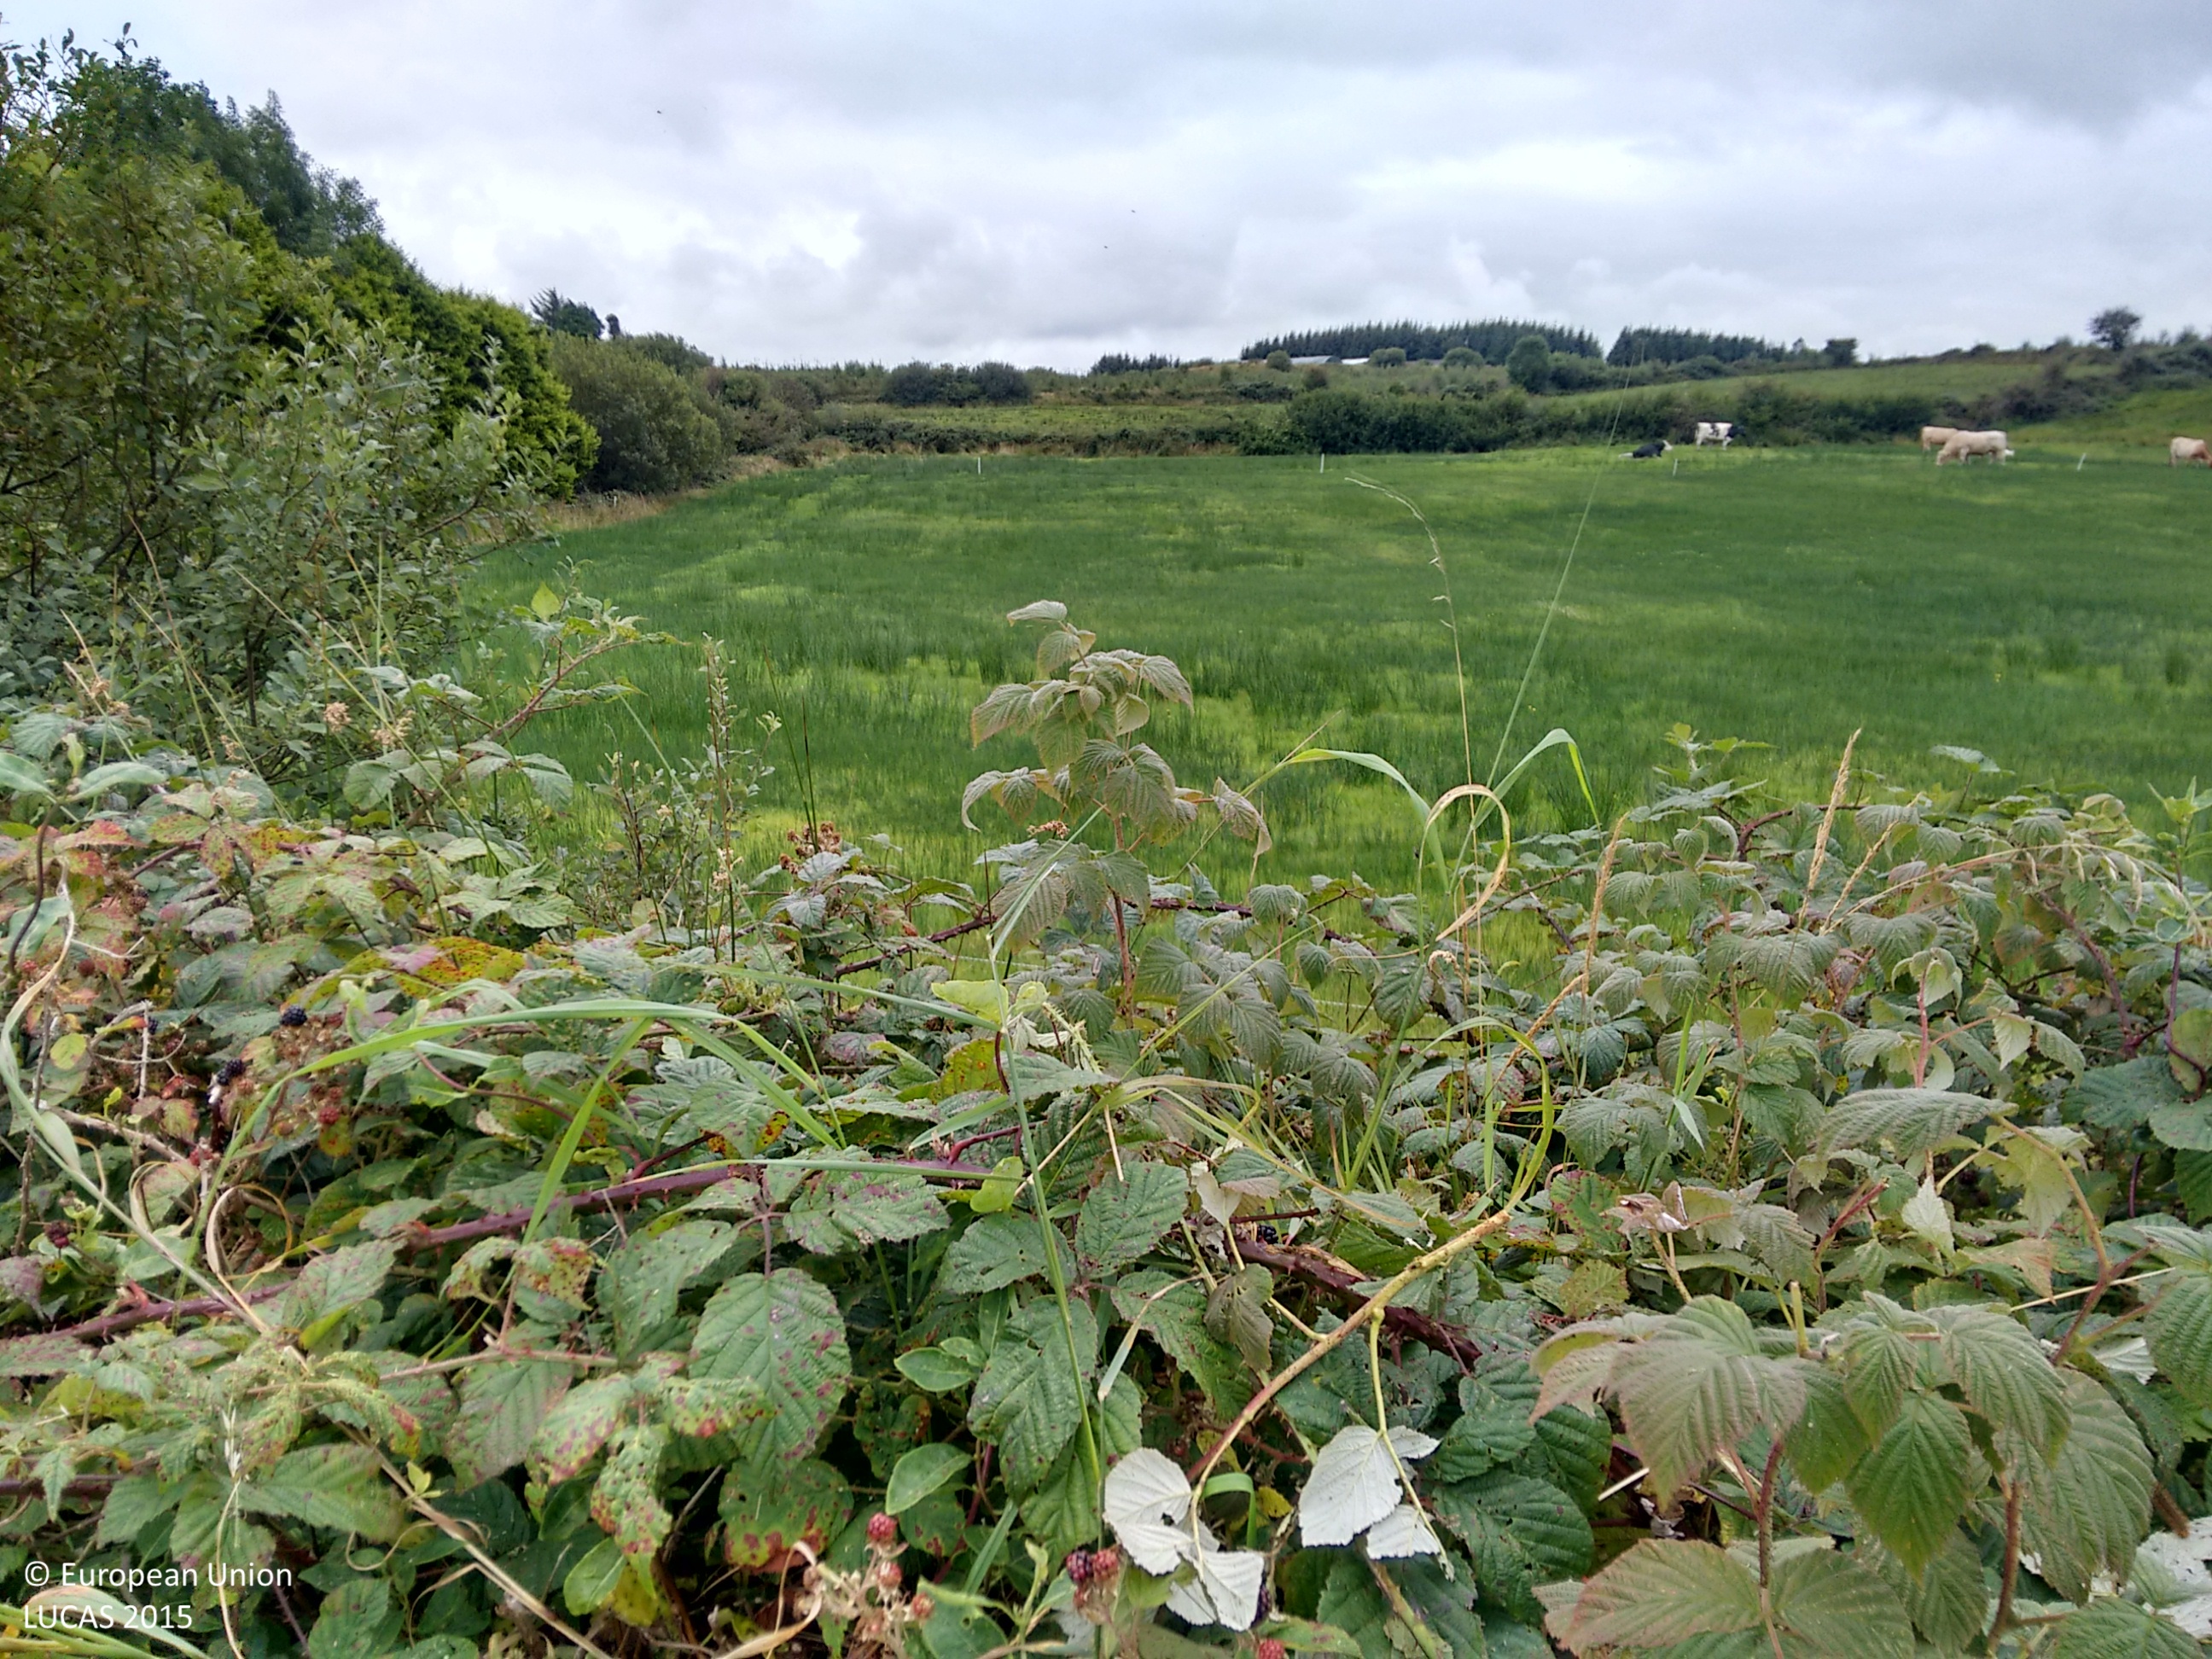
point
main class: Grassland
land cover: Grassland without tree/shrub cover
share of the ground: > 75 %
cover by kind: herbaceous plants 100 %
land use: Agriculture (excluding fallow land and kitchen gardens)
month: September
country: IE
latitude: 52.8338
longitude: -9.1442
